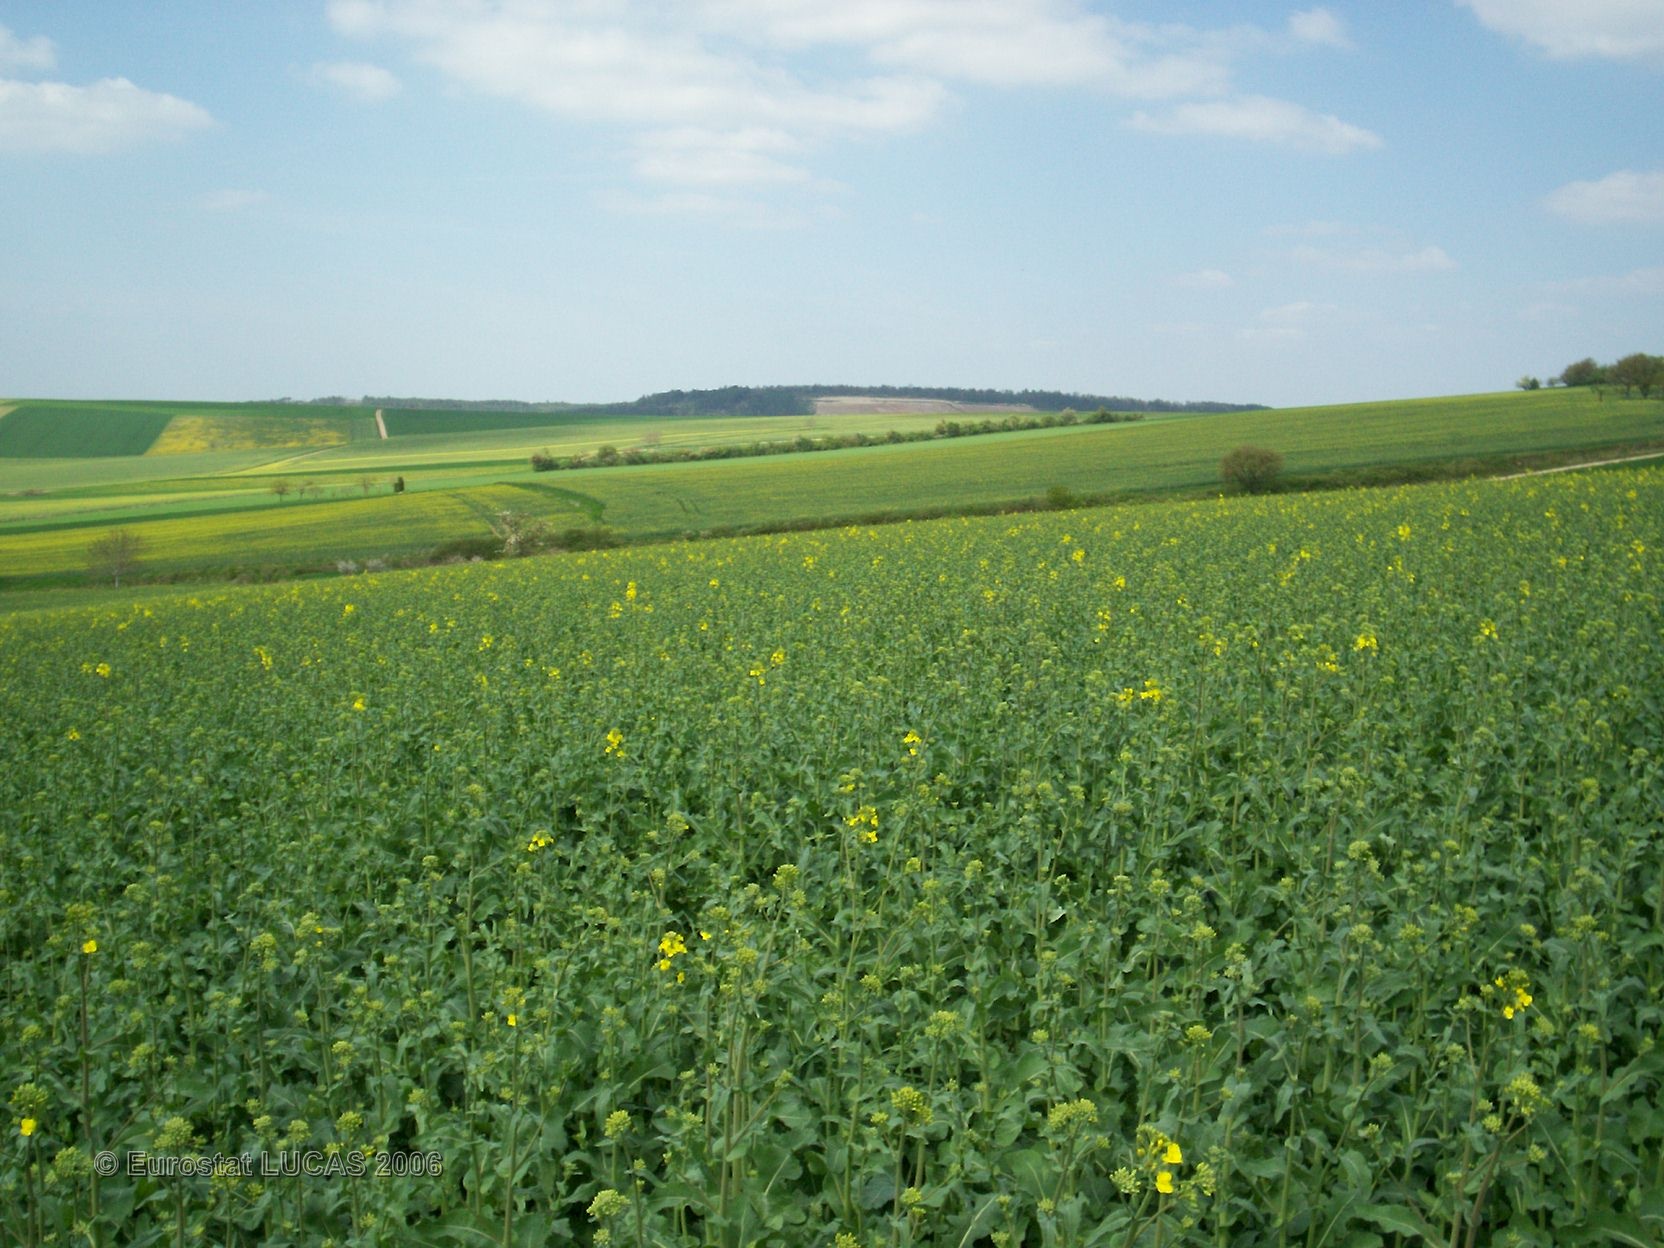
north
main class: Cropland
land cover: Rape and turnip rape
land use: Agriculture (excluding fallow land and kitchen gardens)
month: April
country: FR
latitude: 47.9431
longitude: 4.5226
